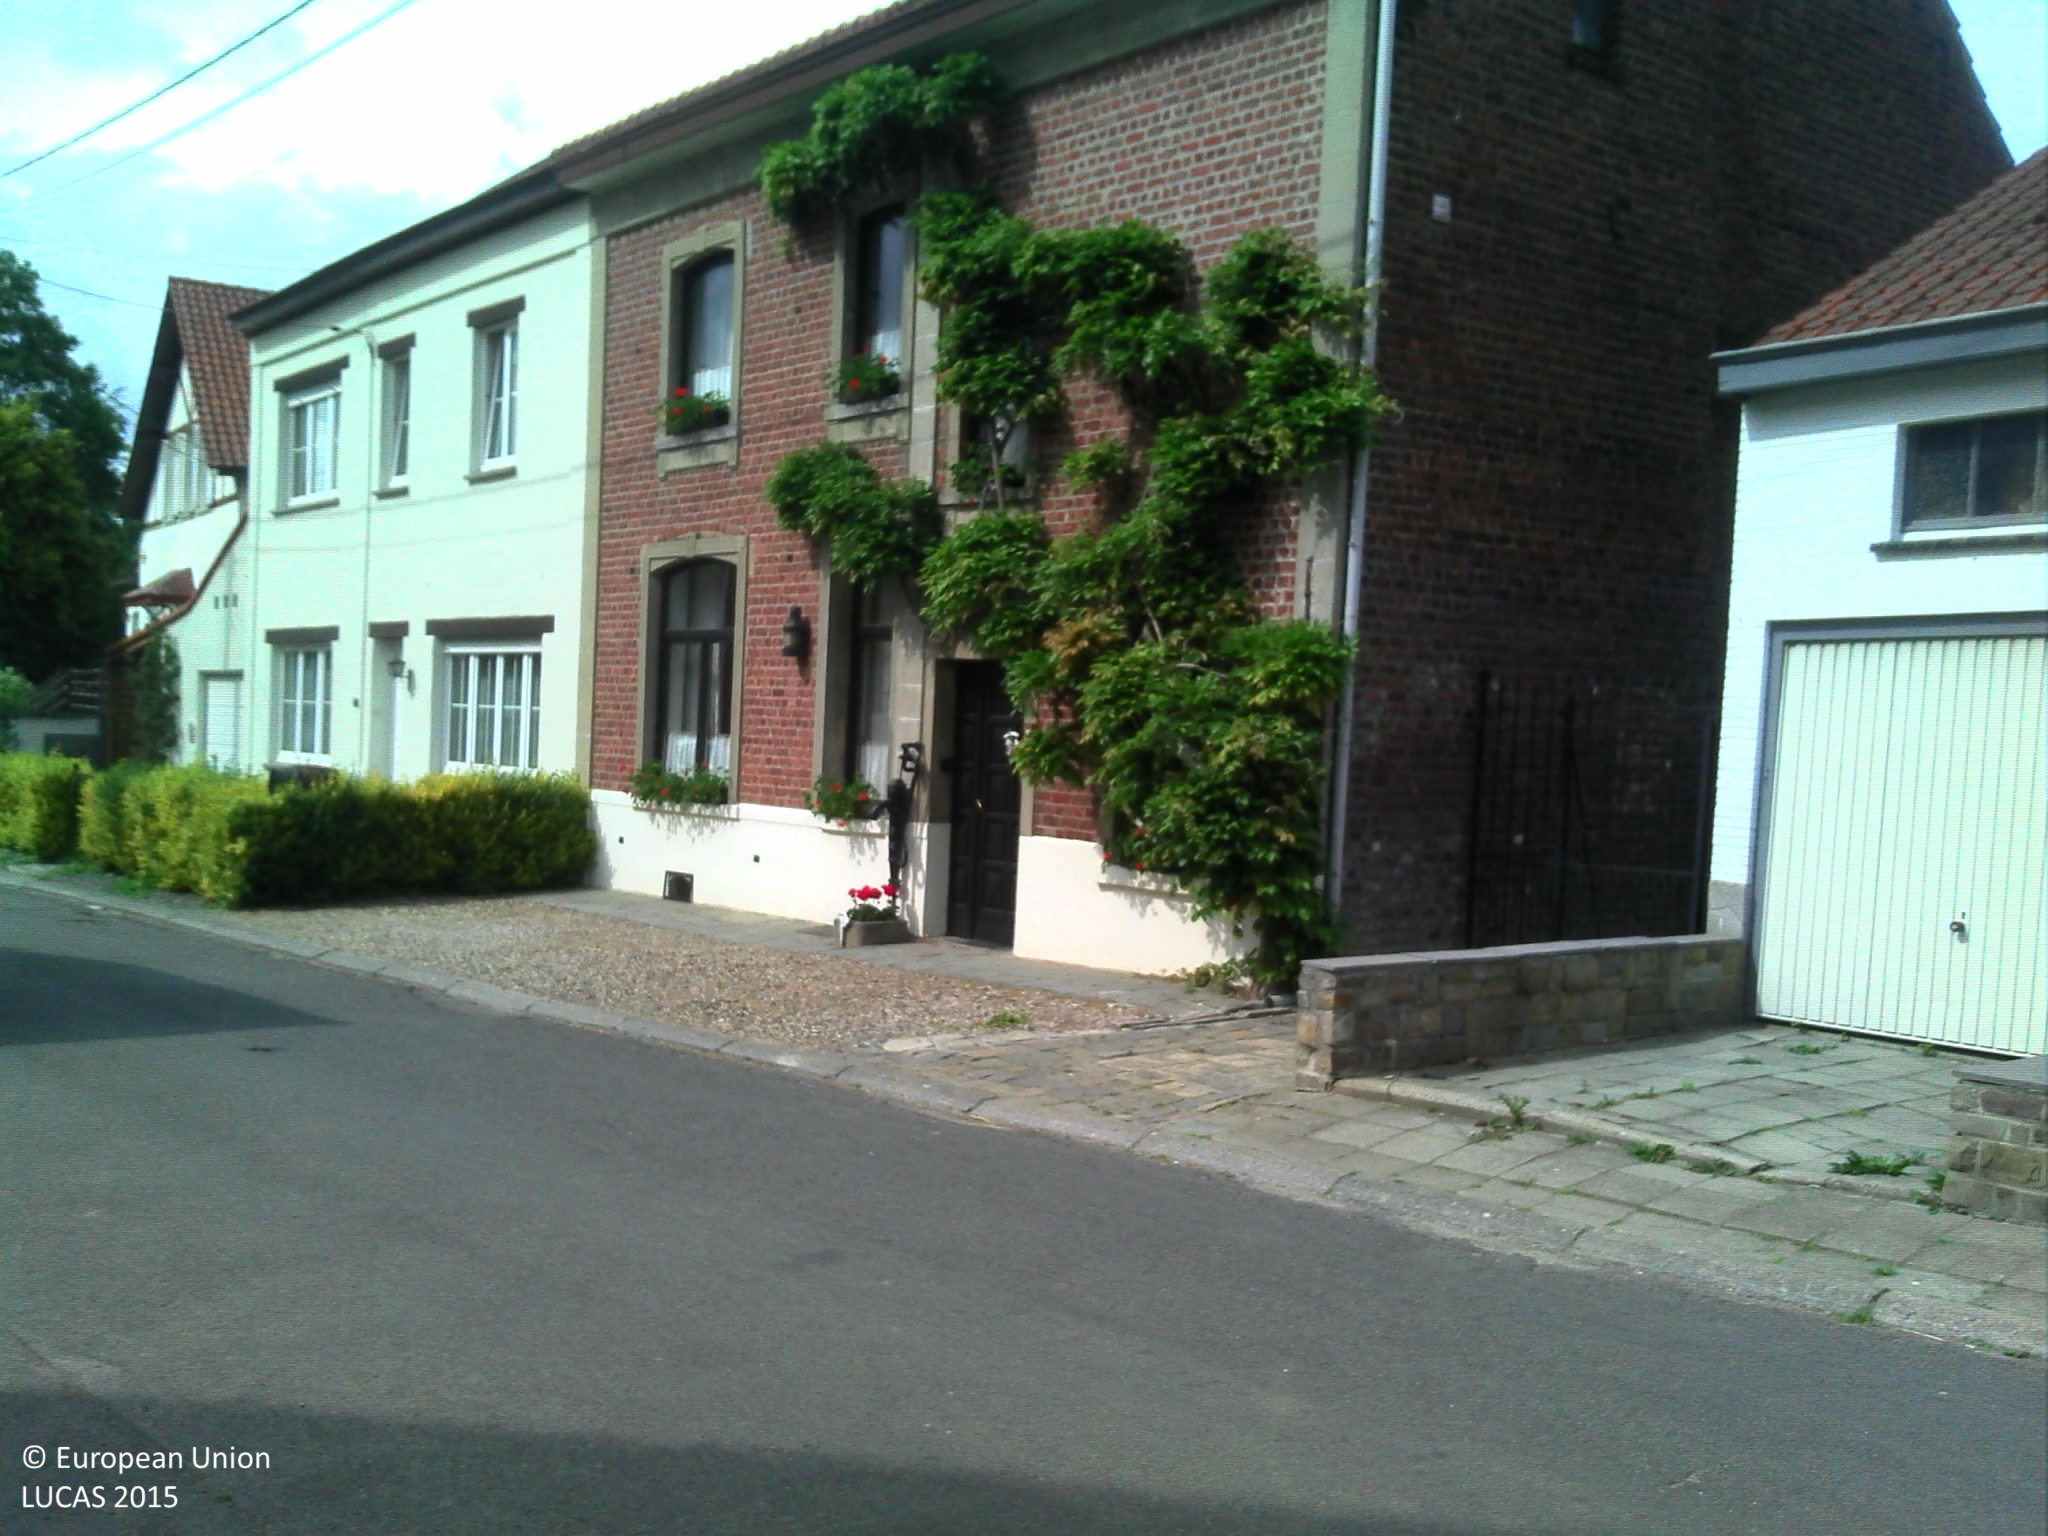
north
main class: Grassland
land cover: Grassland with sparse tree/shrub cover
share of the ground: > 75 %
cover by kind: herbaceous plants 95 %, broadleaved forest trees 5 %
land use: Residential
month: May
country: BE
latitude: 50.7808
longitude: 4.6777
